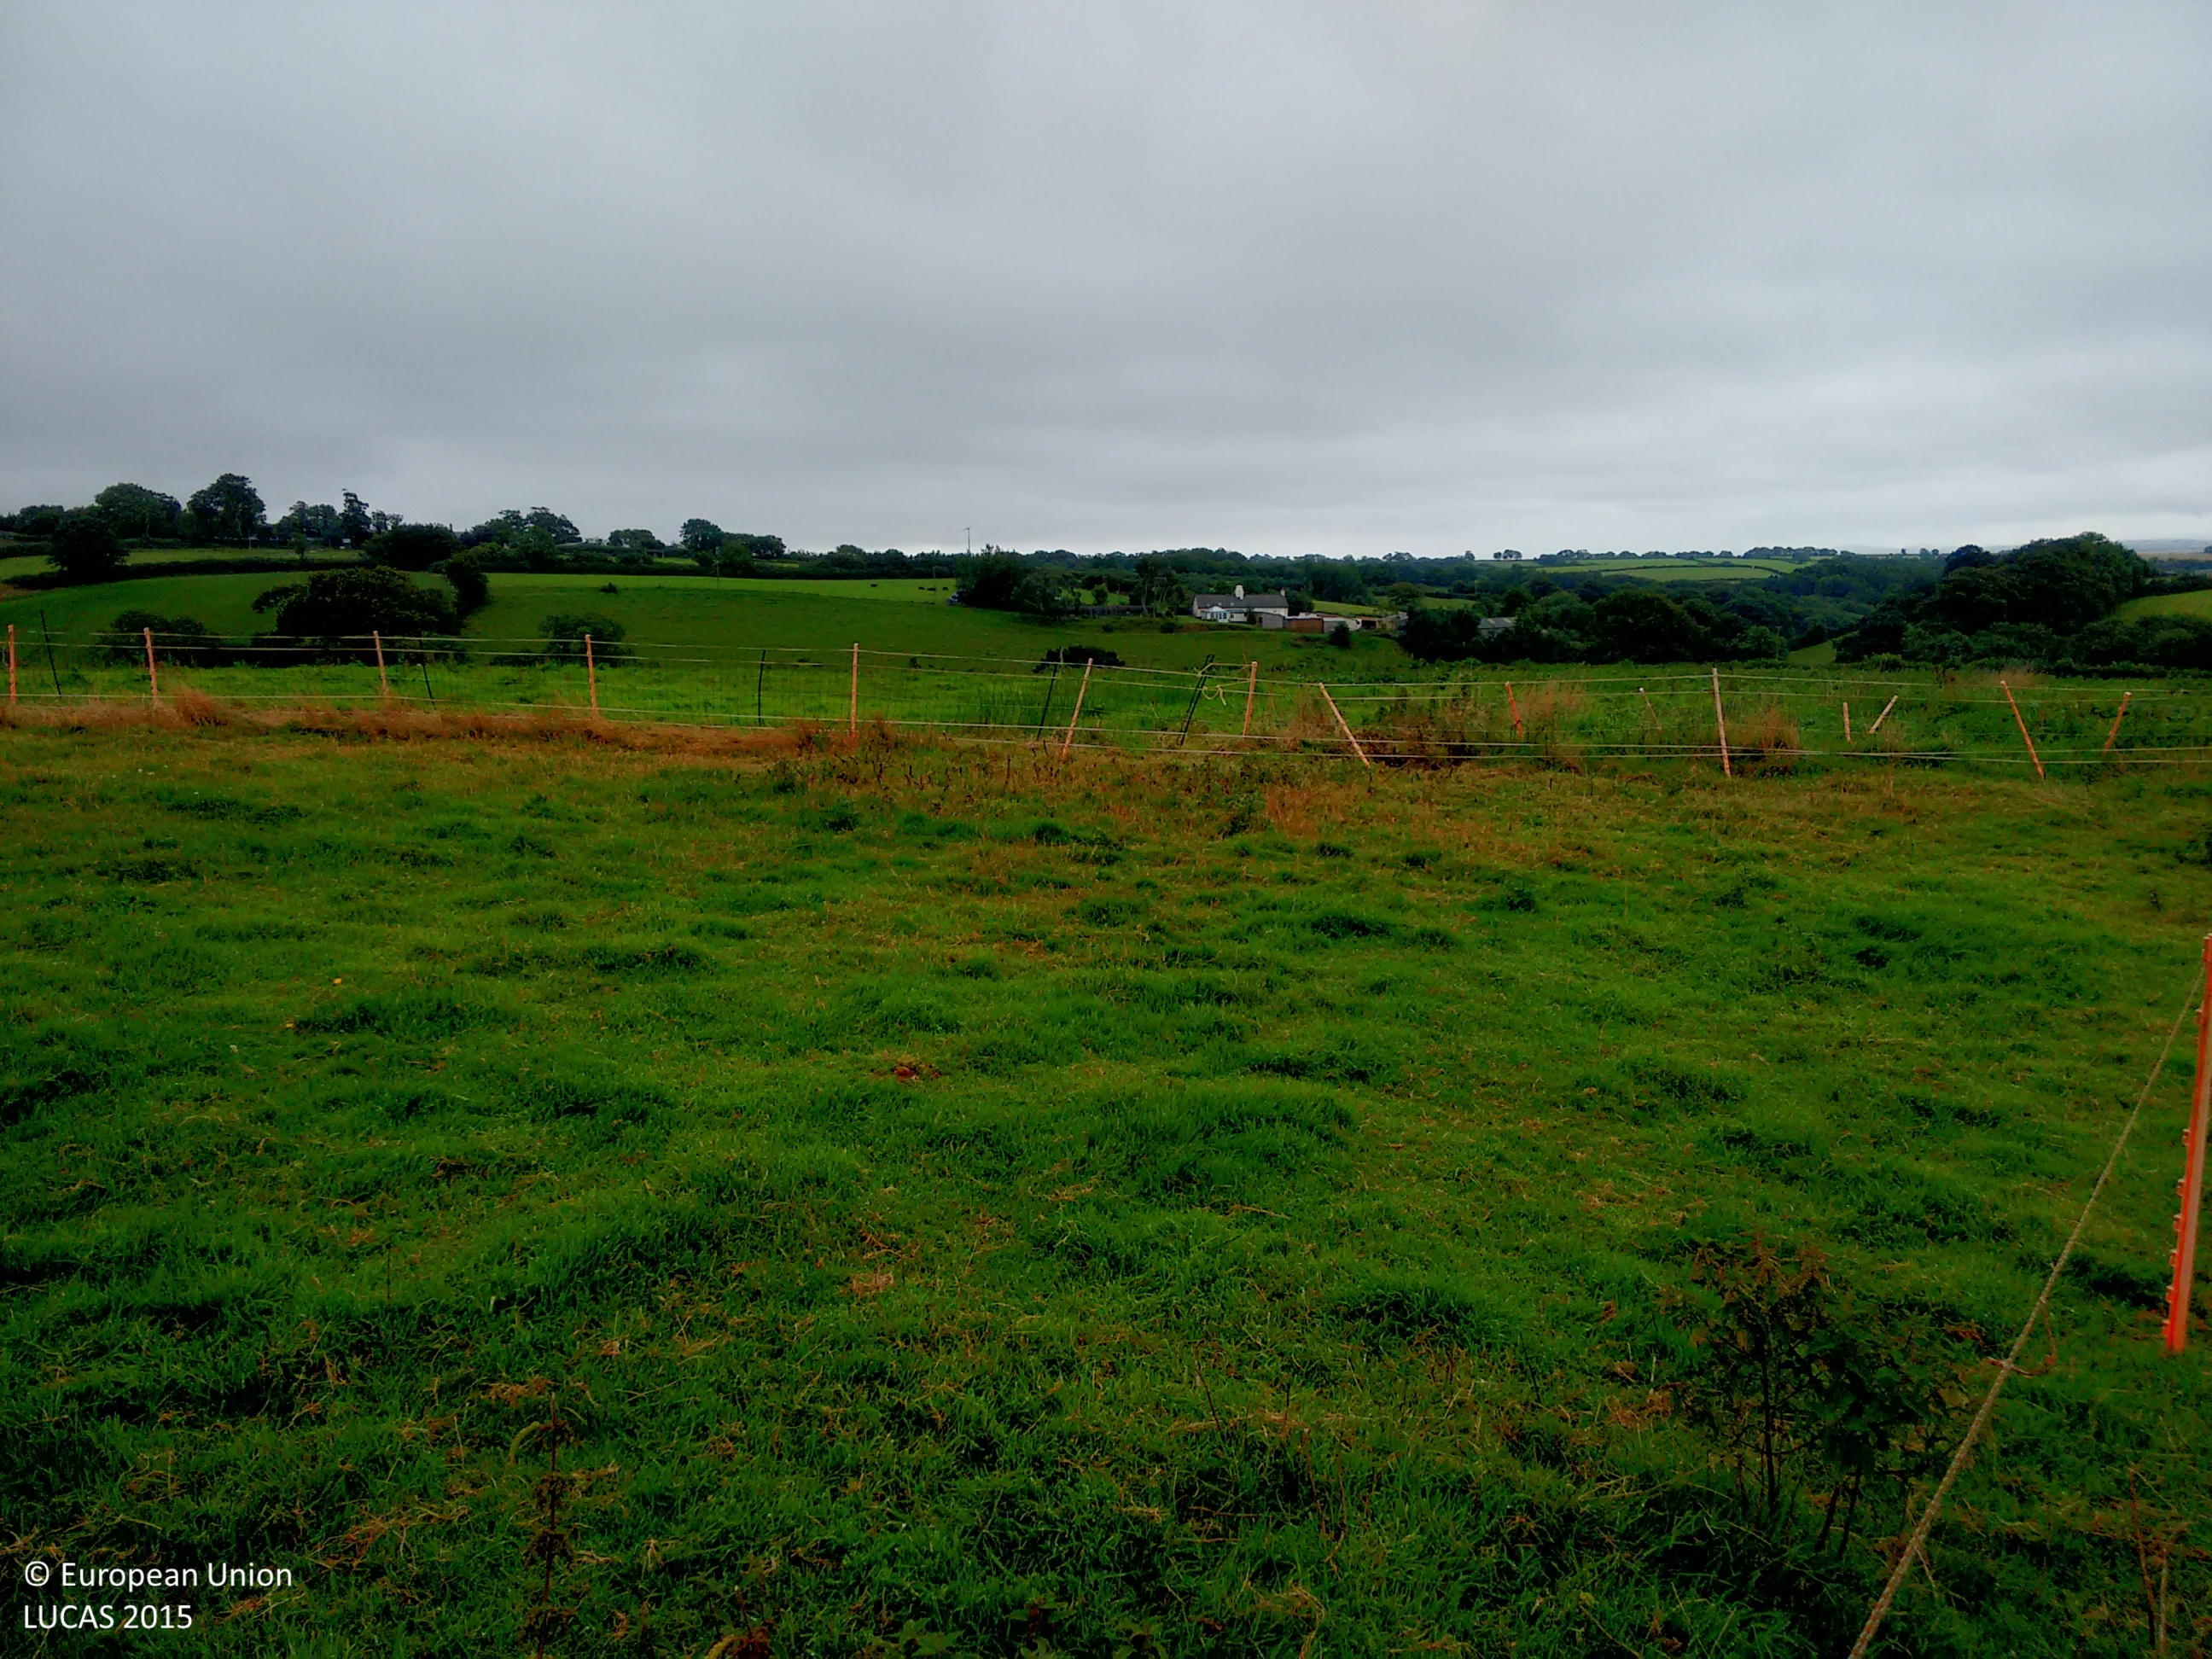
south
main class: Grassland
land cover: Spontaneously vegetated surfaces
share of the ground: > 75 %
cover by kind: herbaceous plants 100 %
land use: Agriculture (excluding fallow land and kitchen gardens)
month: August
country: GB
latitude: 50.8925
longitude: -3.6354
